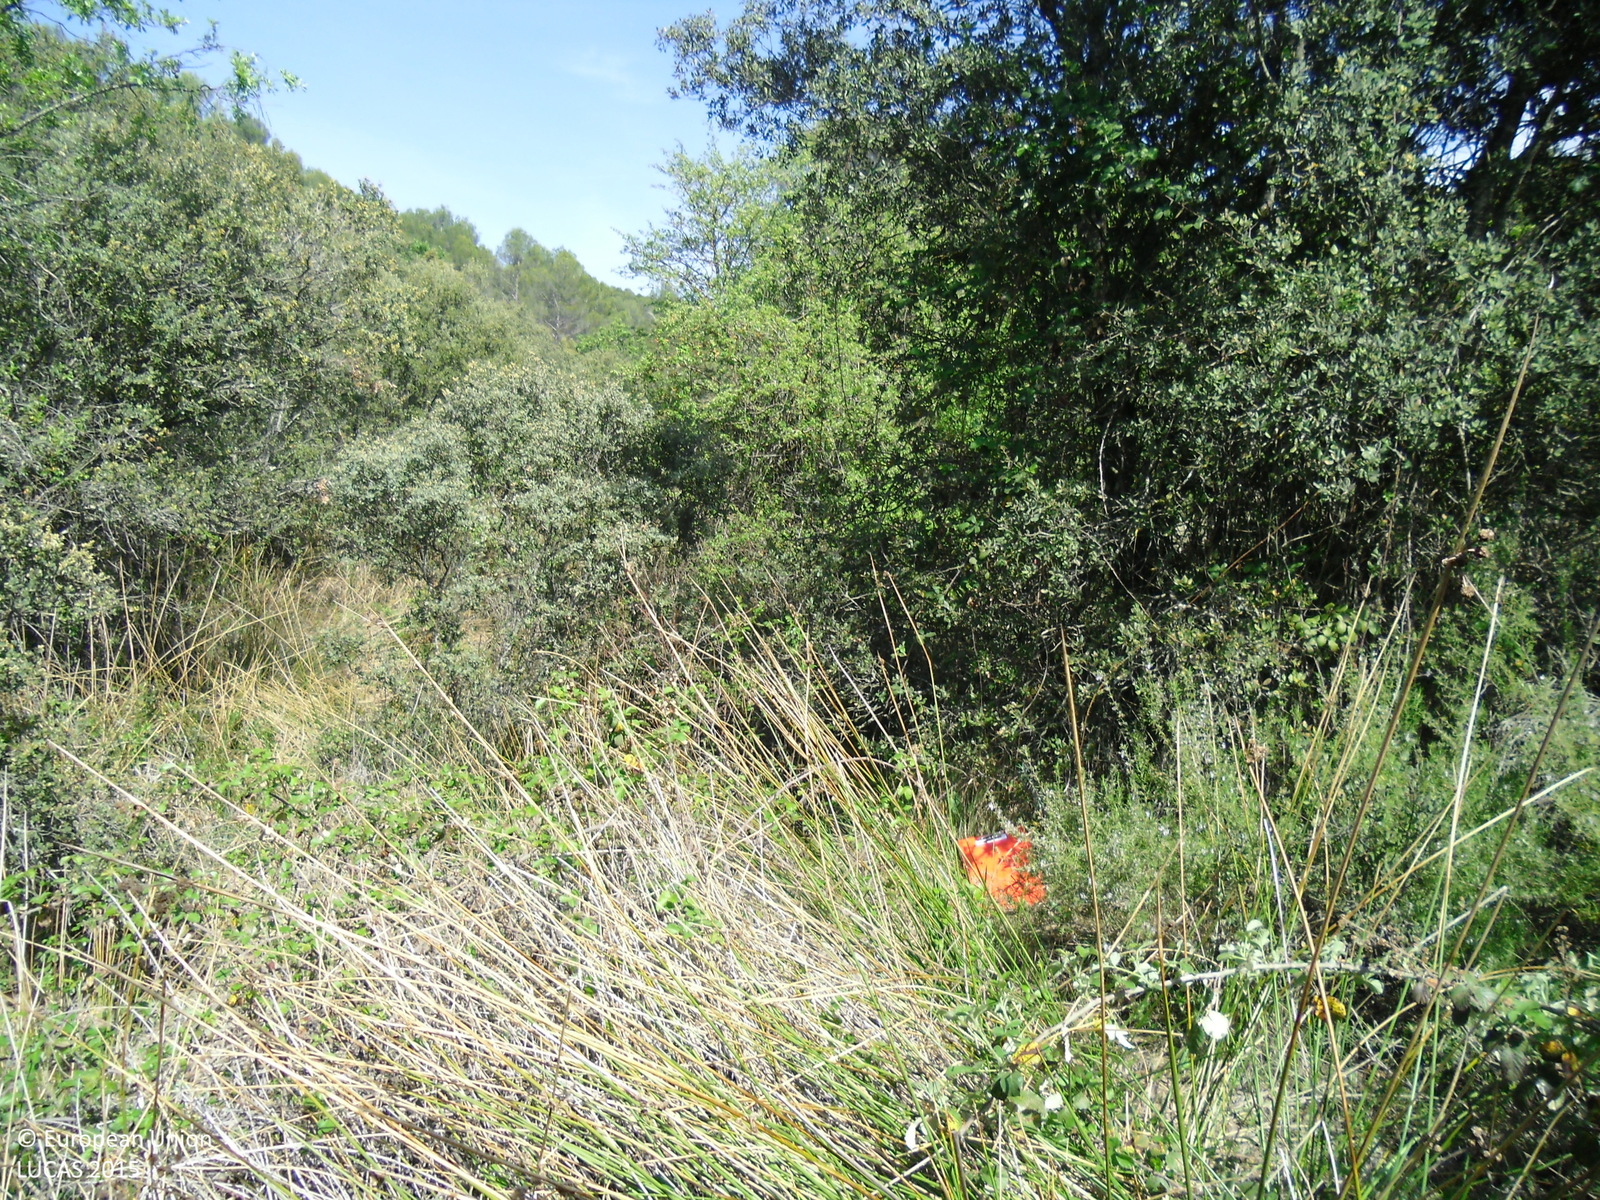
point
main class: Woodland
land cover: Broadleaved woodland
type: broadleaved evergreen forest
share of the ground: > 75 %
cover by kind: broadleaved forest trees 85 %, shrubs 15 %
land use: Semi-natural and natural areas not in use
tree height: > 5 m
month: May
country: ES
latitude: 40.4609
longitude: -2.9897
